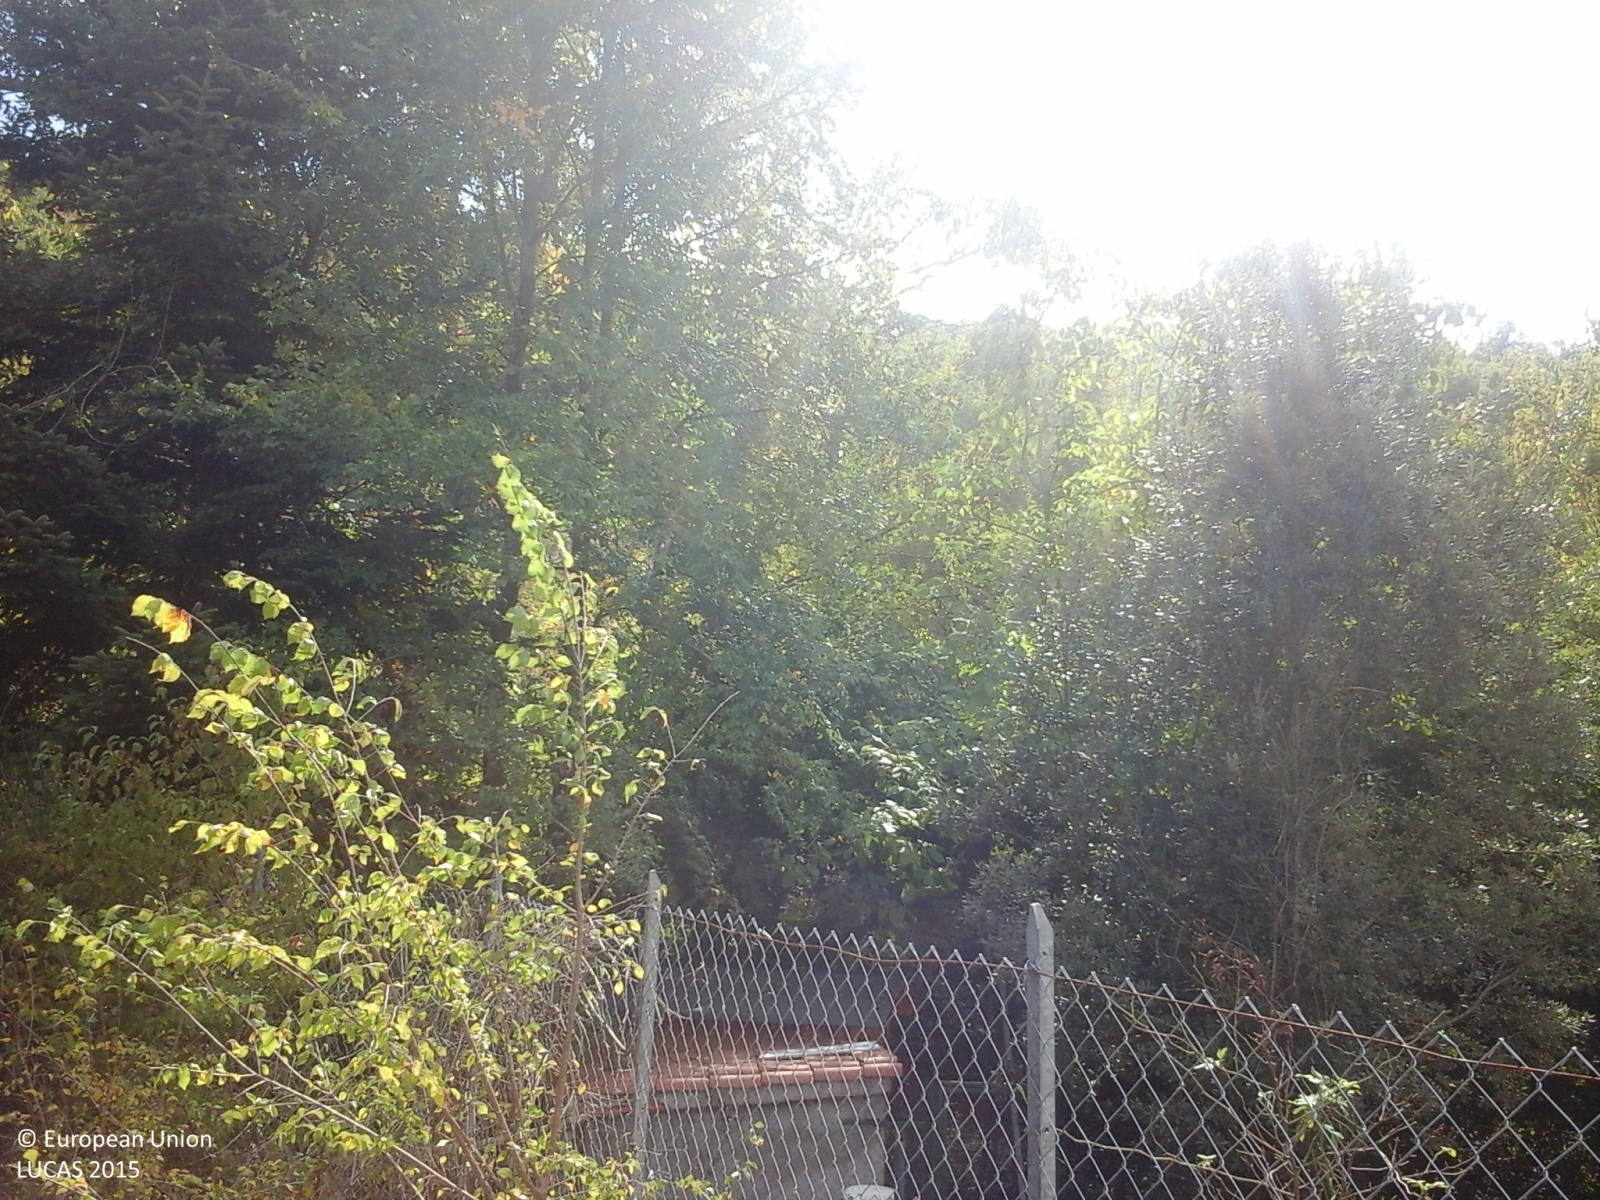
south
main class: Woodland
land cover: Broadleaved woodland
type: thermophilous deciduous forest
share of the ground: > 75 %
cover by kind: broadleaved forest trees 100 %
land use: Forestry
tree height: > 5 m
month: October
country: IT
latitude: 43.4411
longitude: 12.2796
